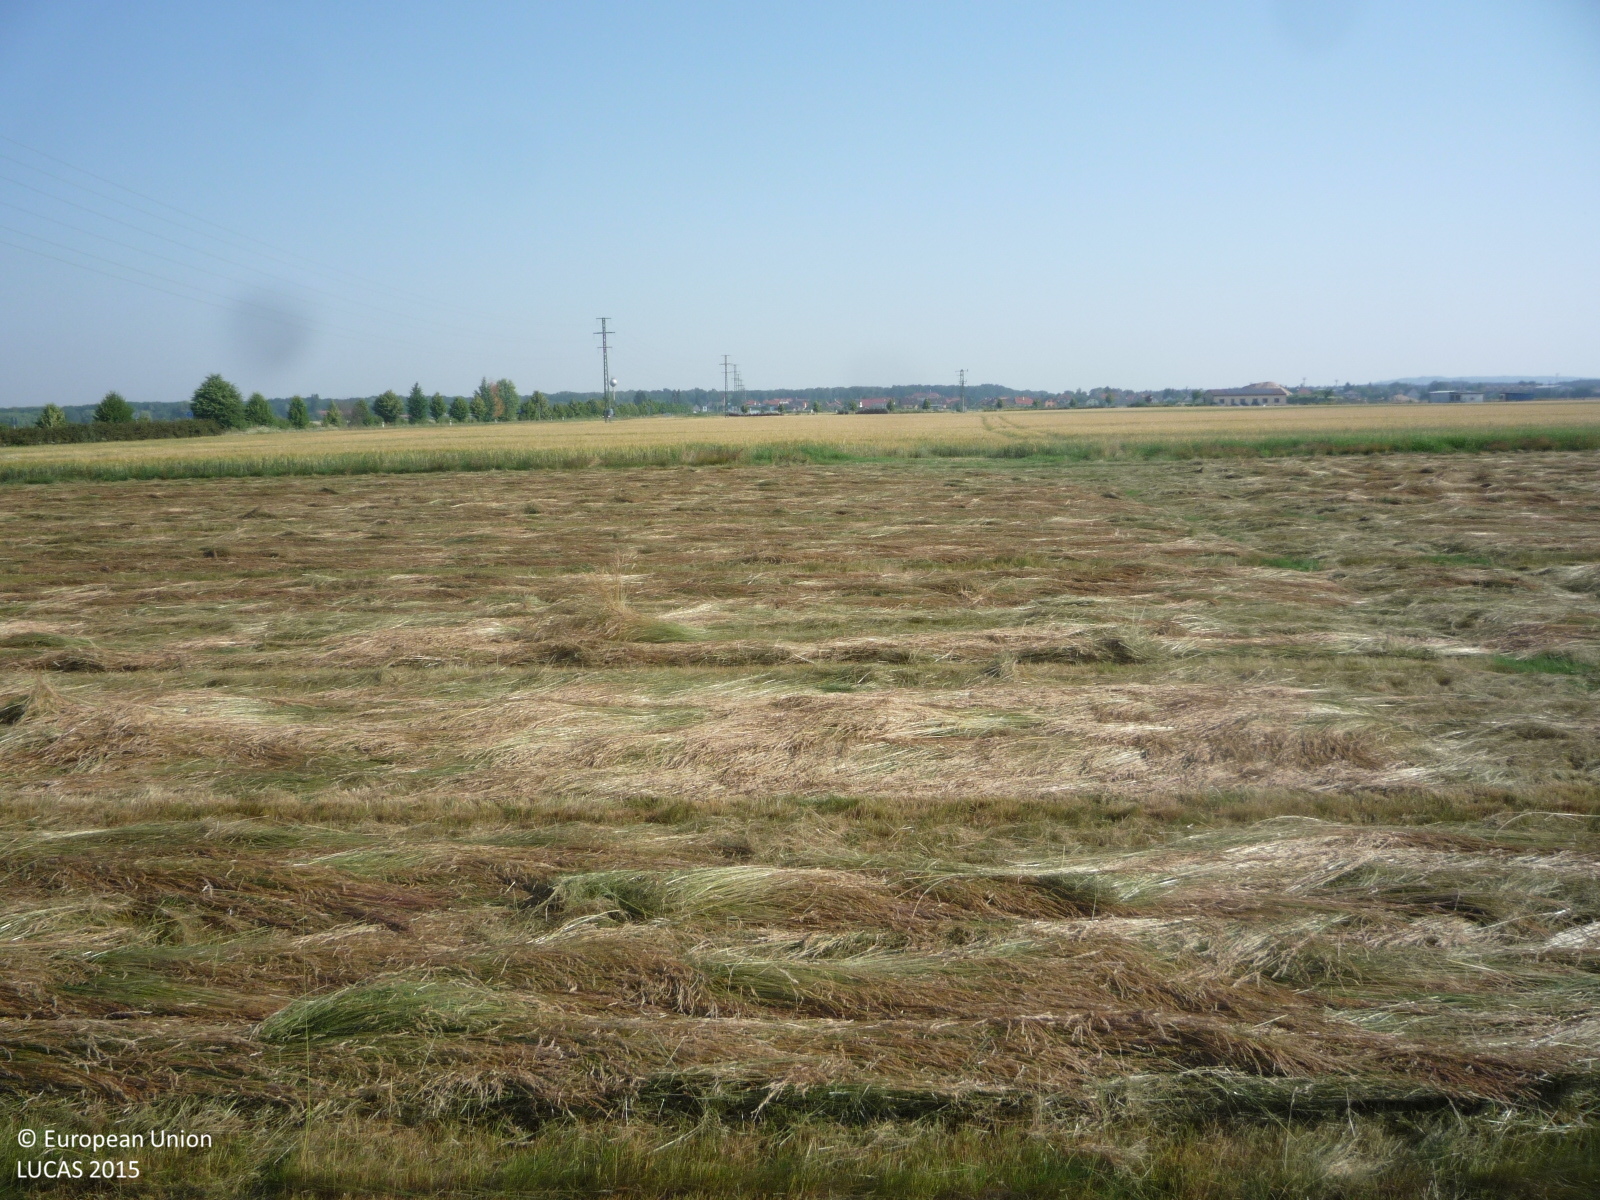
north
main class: Grassland
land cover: Grassland without tree/shrub cover
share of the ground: > 75 %
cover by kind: herbaceous plants 100 %
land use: Agriculture (excluding fallow land and kitchen gardens)
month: July
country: CZ
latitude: 50.0842
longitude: 15.1881
